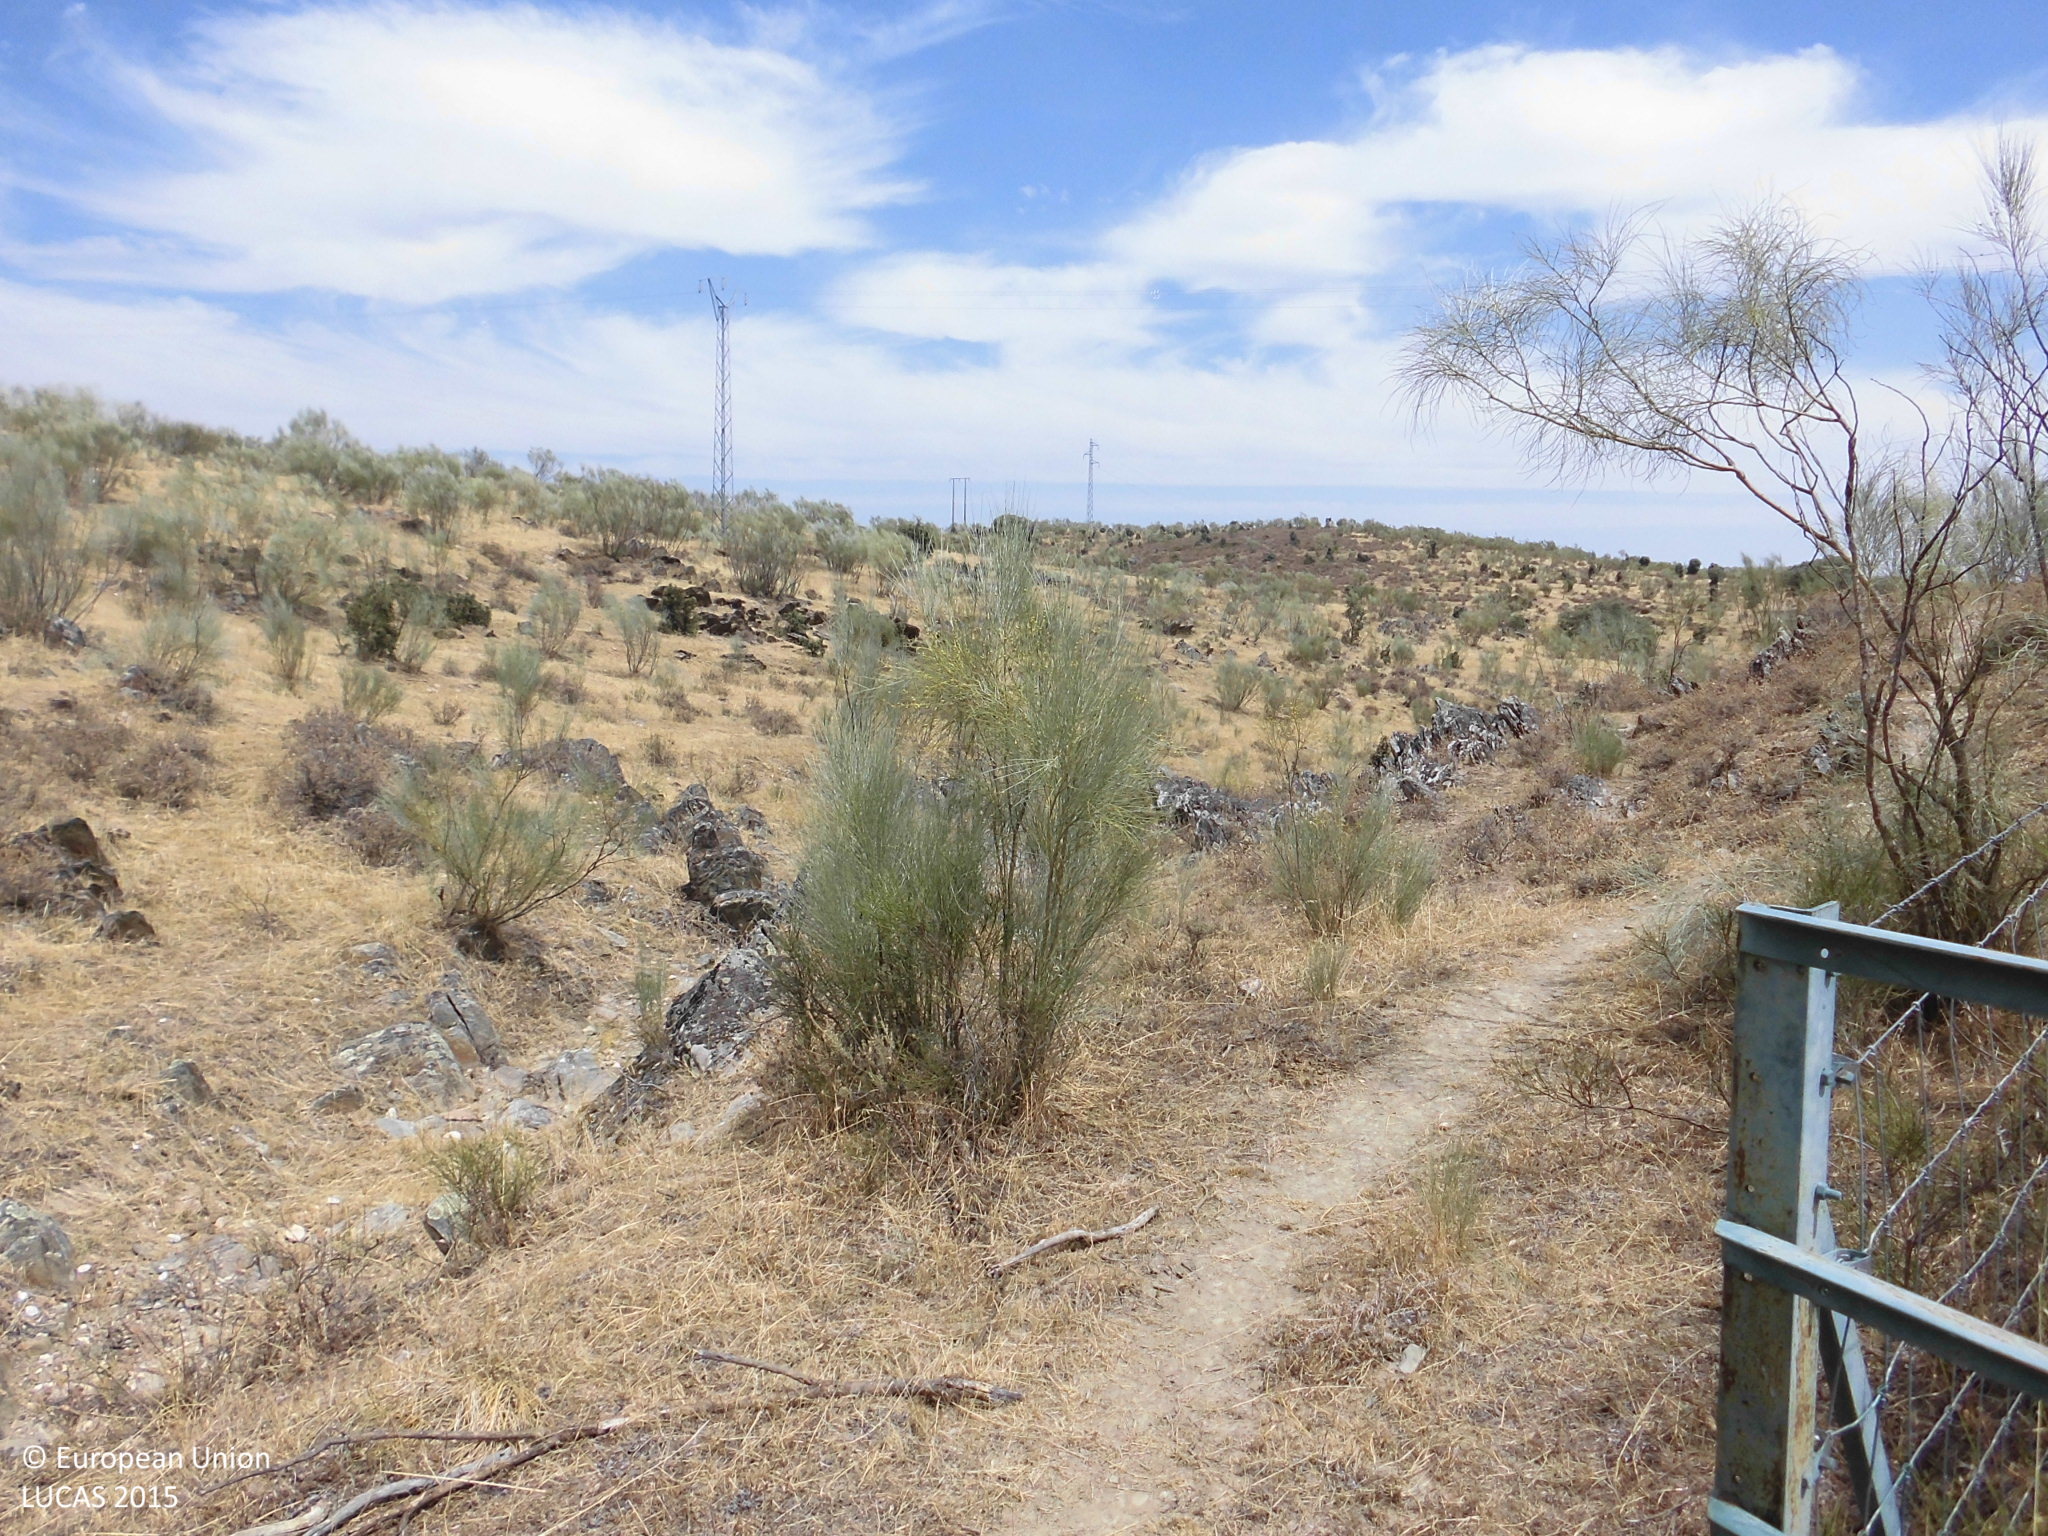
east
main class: Shrubland
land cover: Shrubland without tree cover
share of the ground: 10 - 25 %
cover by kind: herbaceous plants 85 %, shrubs 15 %
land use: Agriculture (excluding fallow land and kitchen gardens)
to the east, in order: Shrubland without tree cover; Single bushes/trees; Shrubland with sparse tree cover
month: July
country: ES
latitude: 39.7661
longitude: -6.4764
